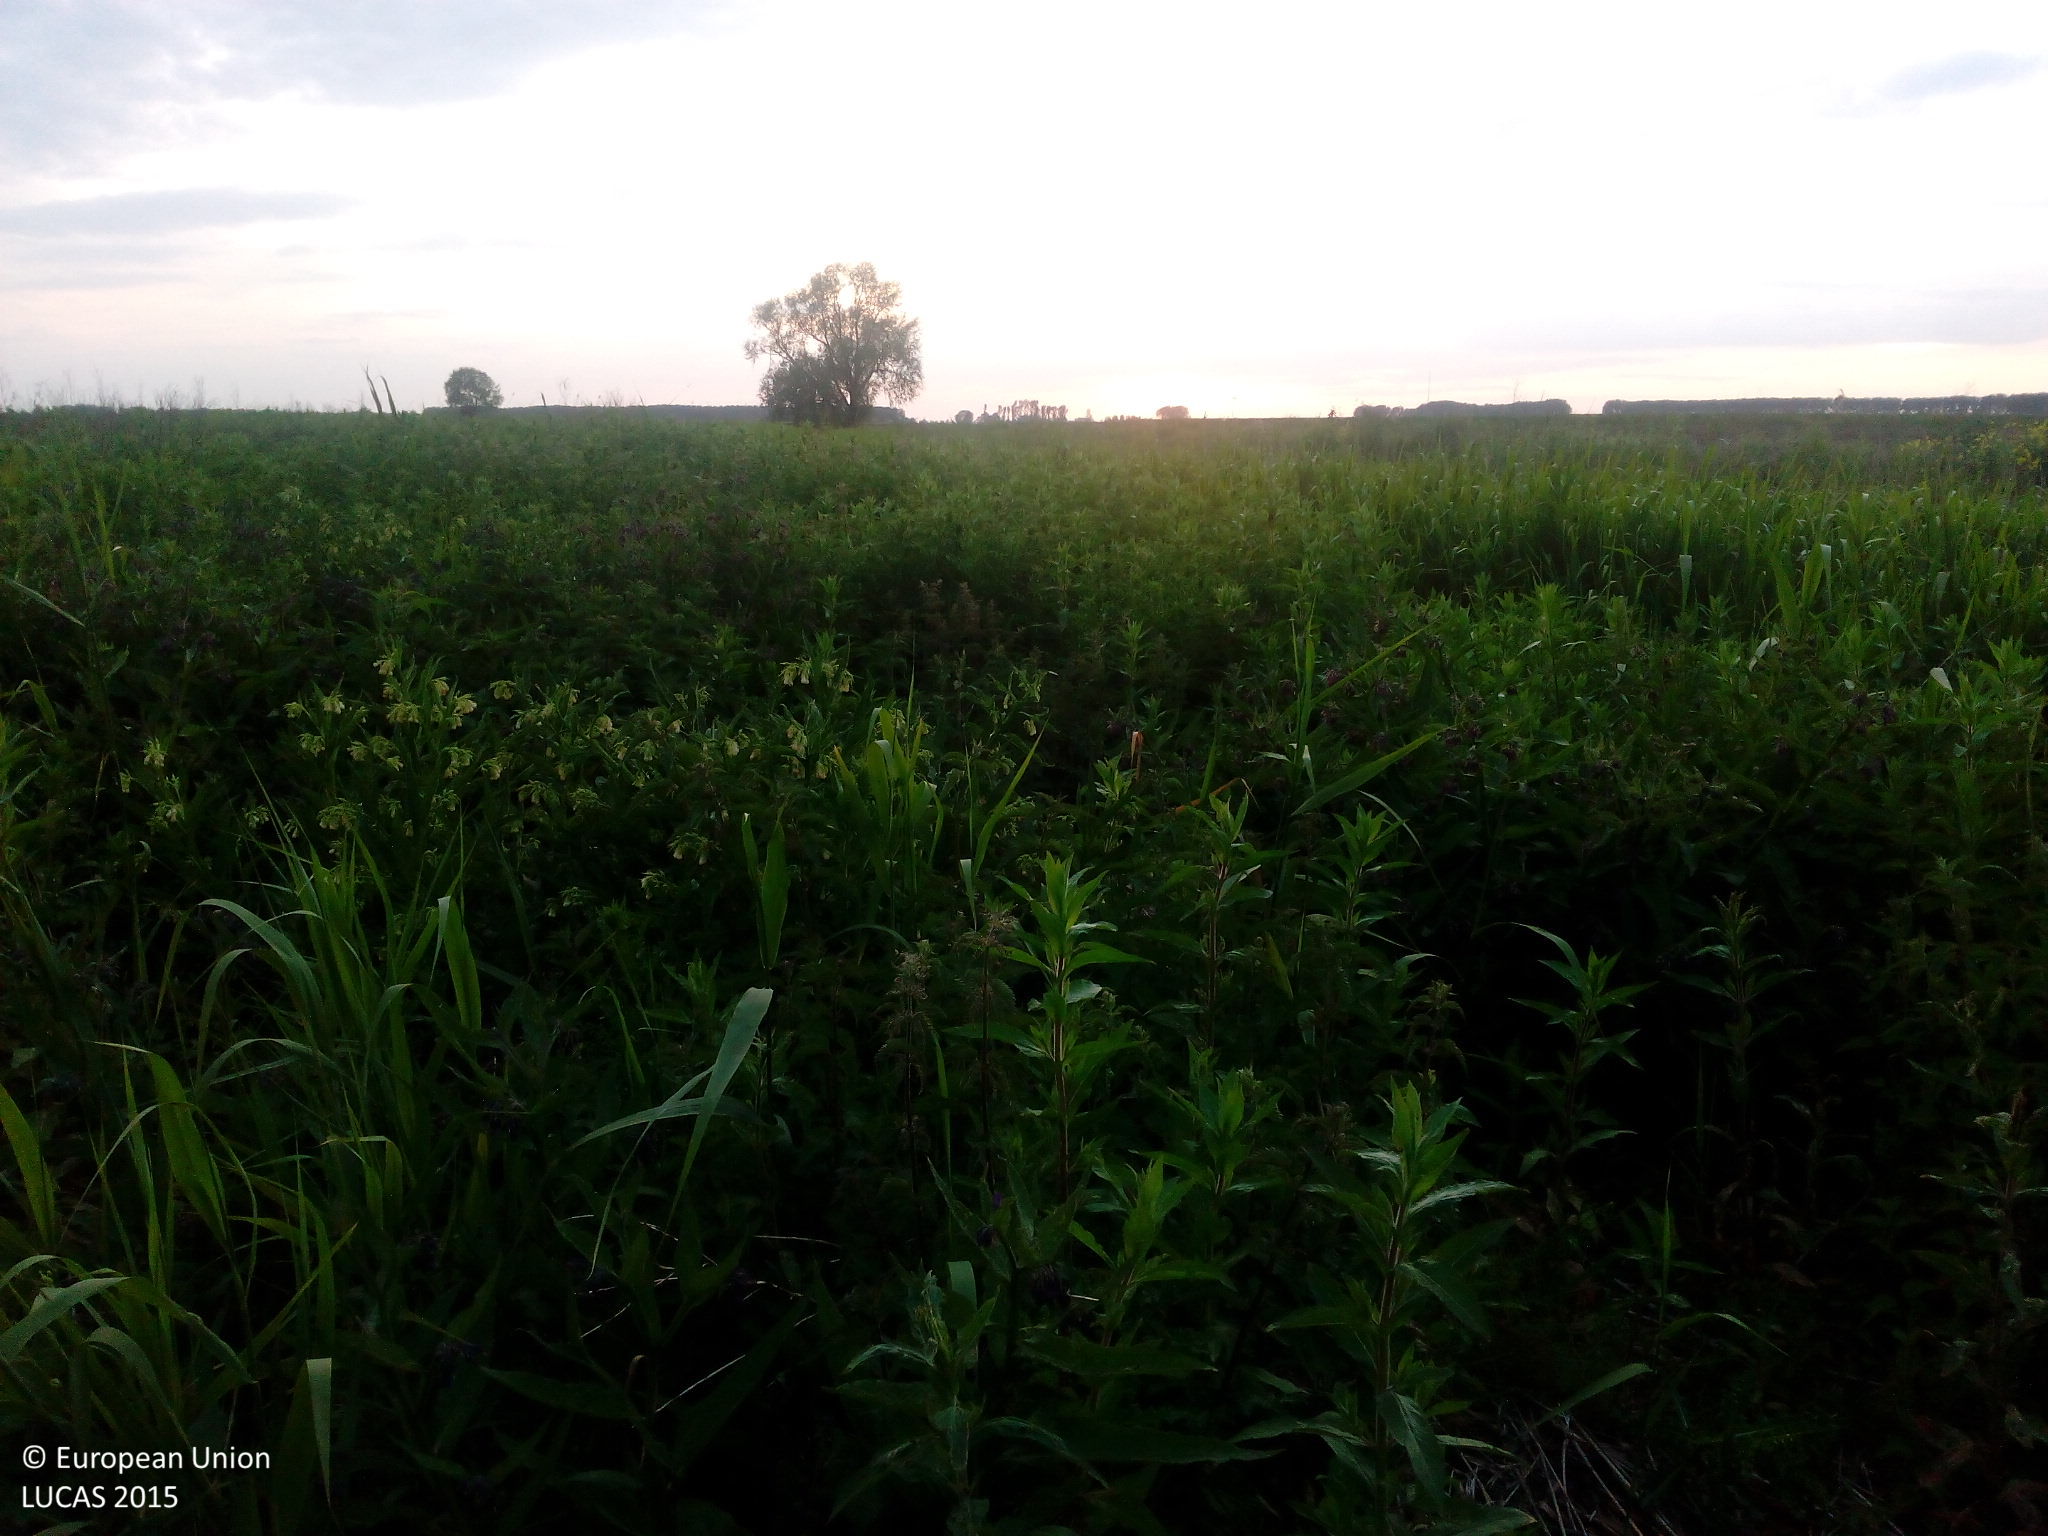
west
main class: Grassland
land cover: Spontaneously vegetated surfaces
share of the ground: 50 - 75 %
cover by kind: herbaceous plants 100 %
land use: Semi-natural and natural areas not in use
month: May
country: NL
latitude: 51.2950
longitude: 4.1291
